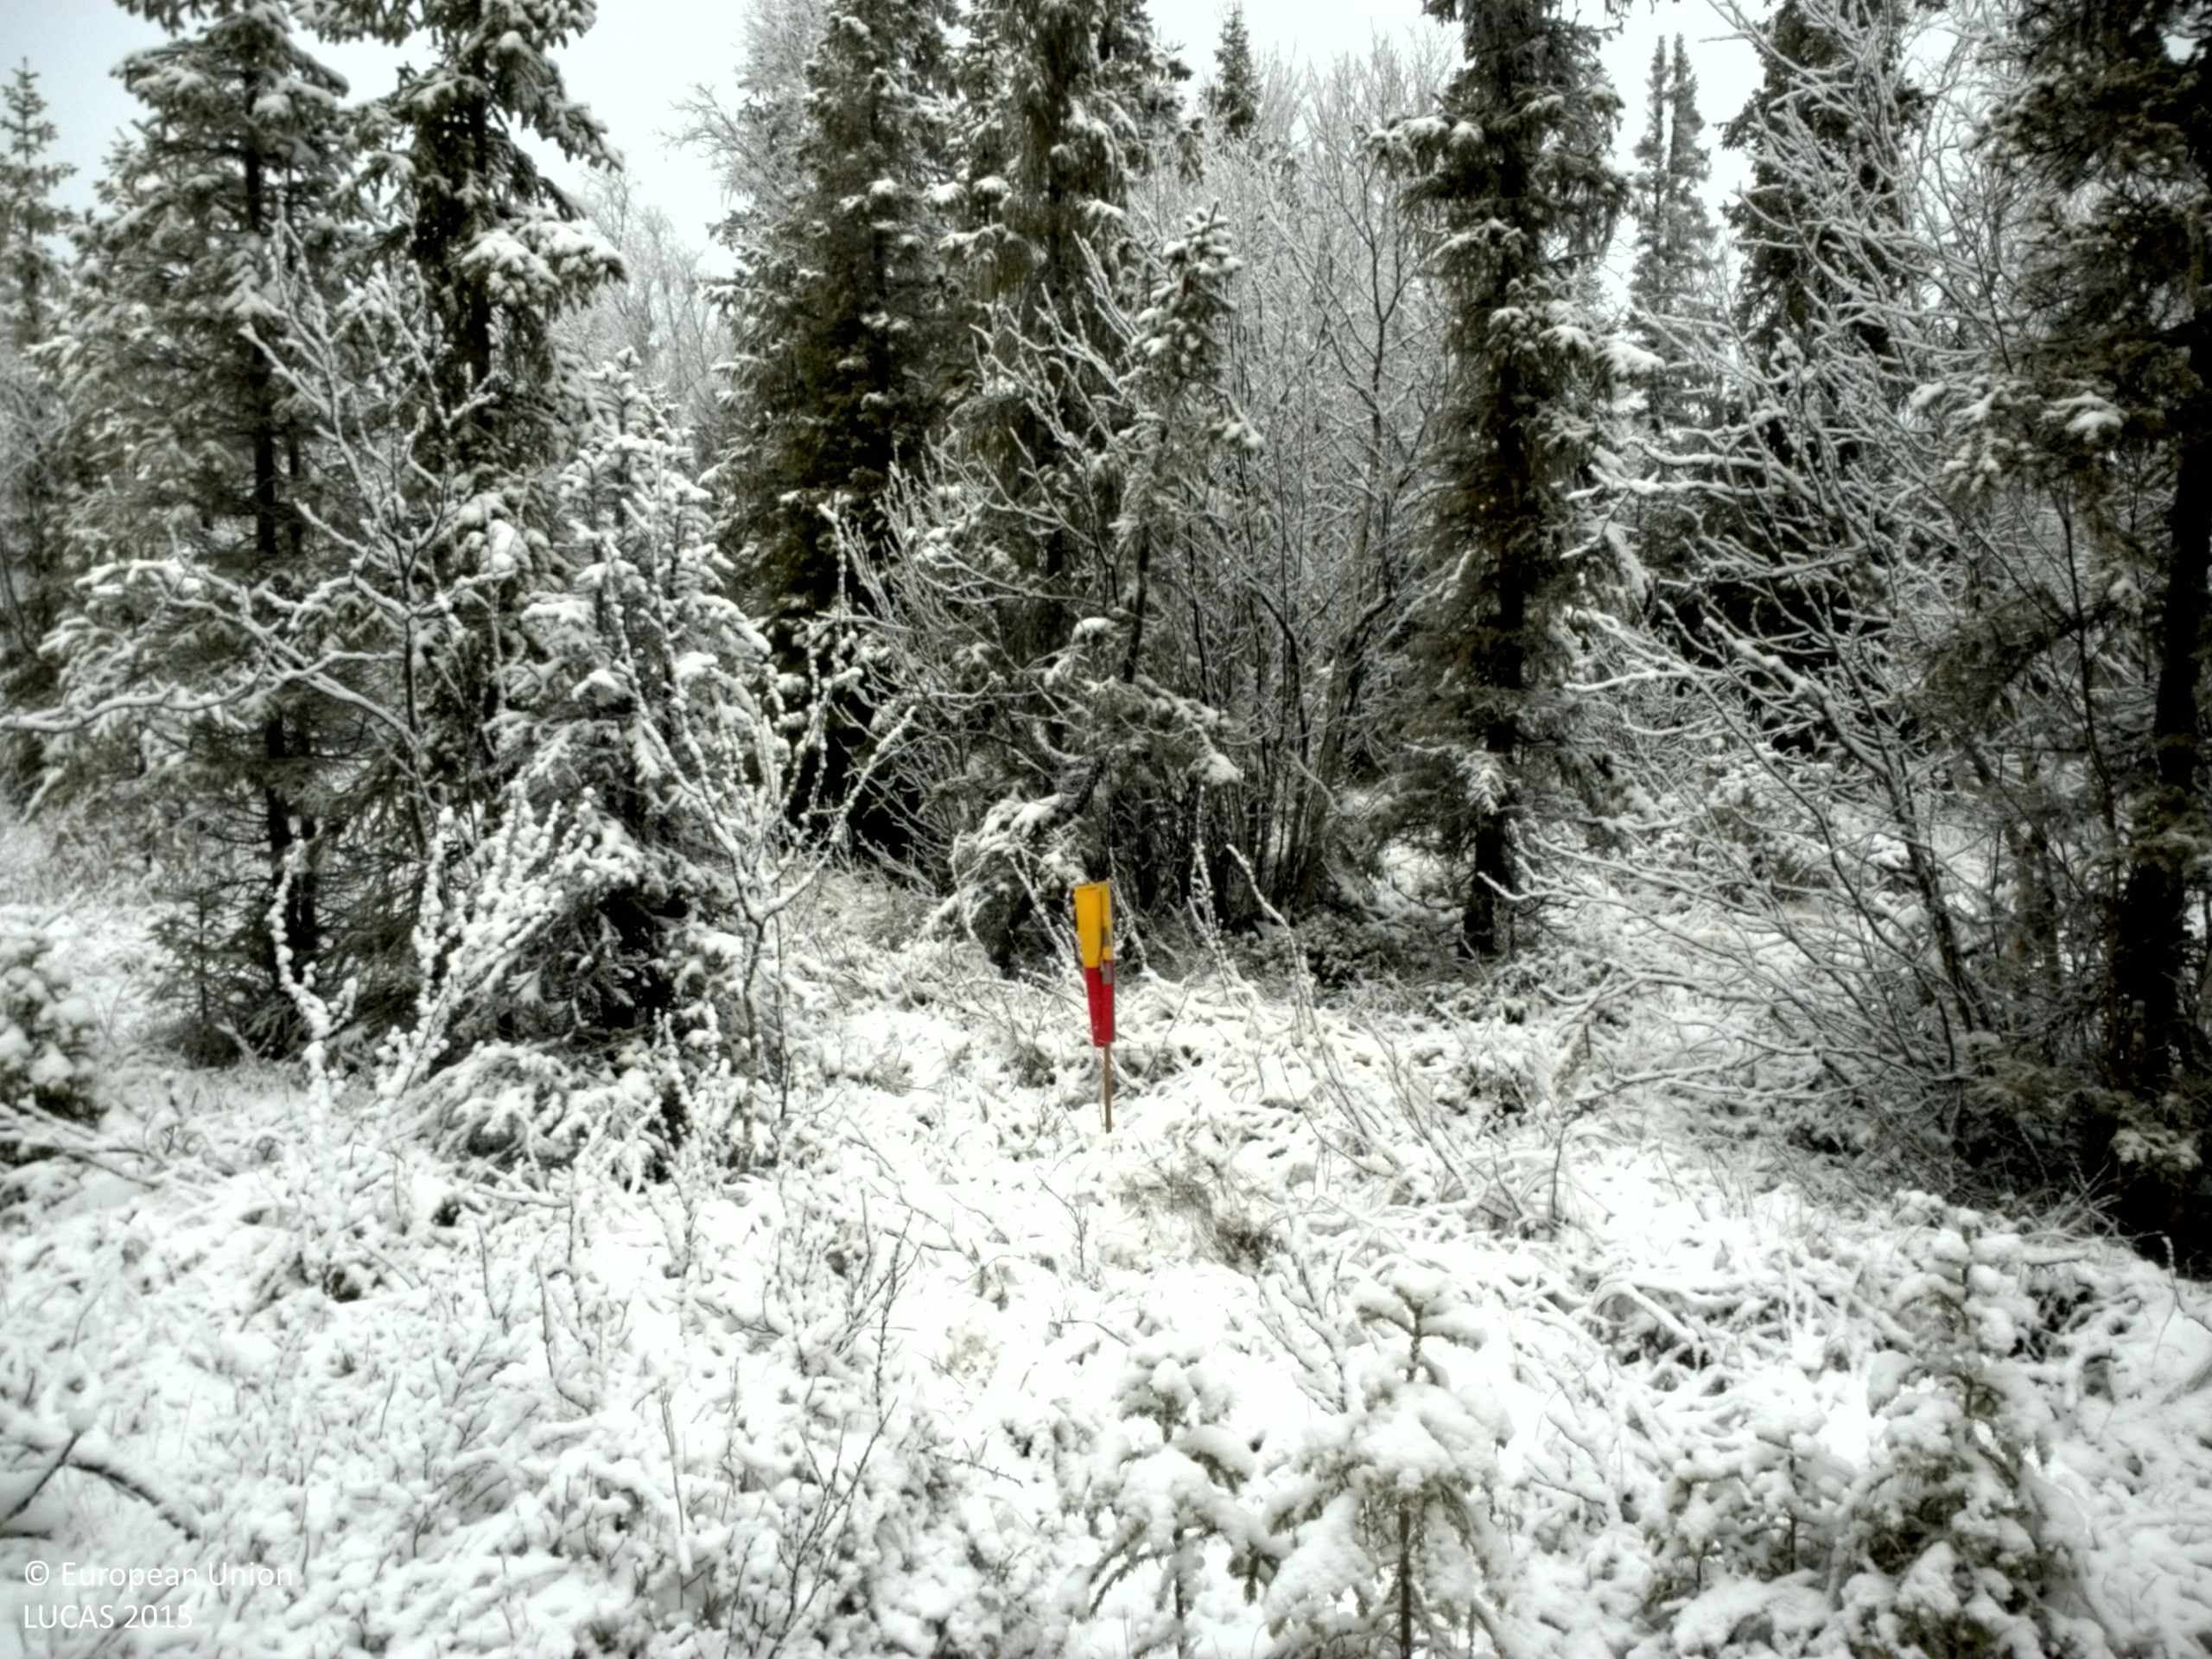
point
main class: Woodland
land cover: Spruce dominated mixed woodland
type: exotic forest
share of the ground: 50 - 75 %
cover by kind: shrubs 35 %, coniferous forest trees 30 %, broadleaved forest trees 20 %, lichens and mosses 15 %
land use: Forestry
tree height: > 5 m
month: November
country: SE
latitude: 63.7292
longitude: 15.3407
